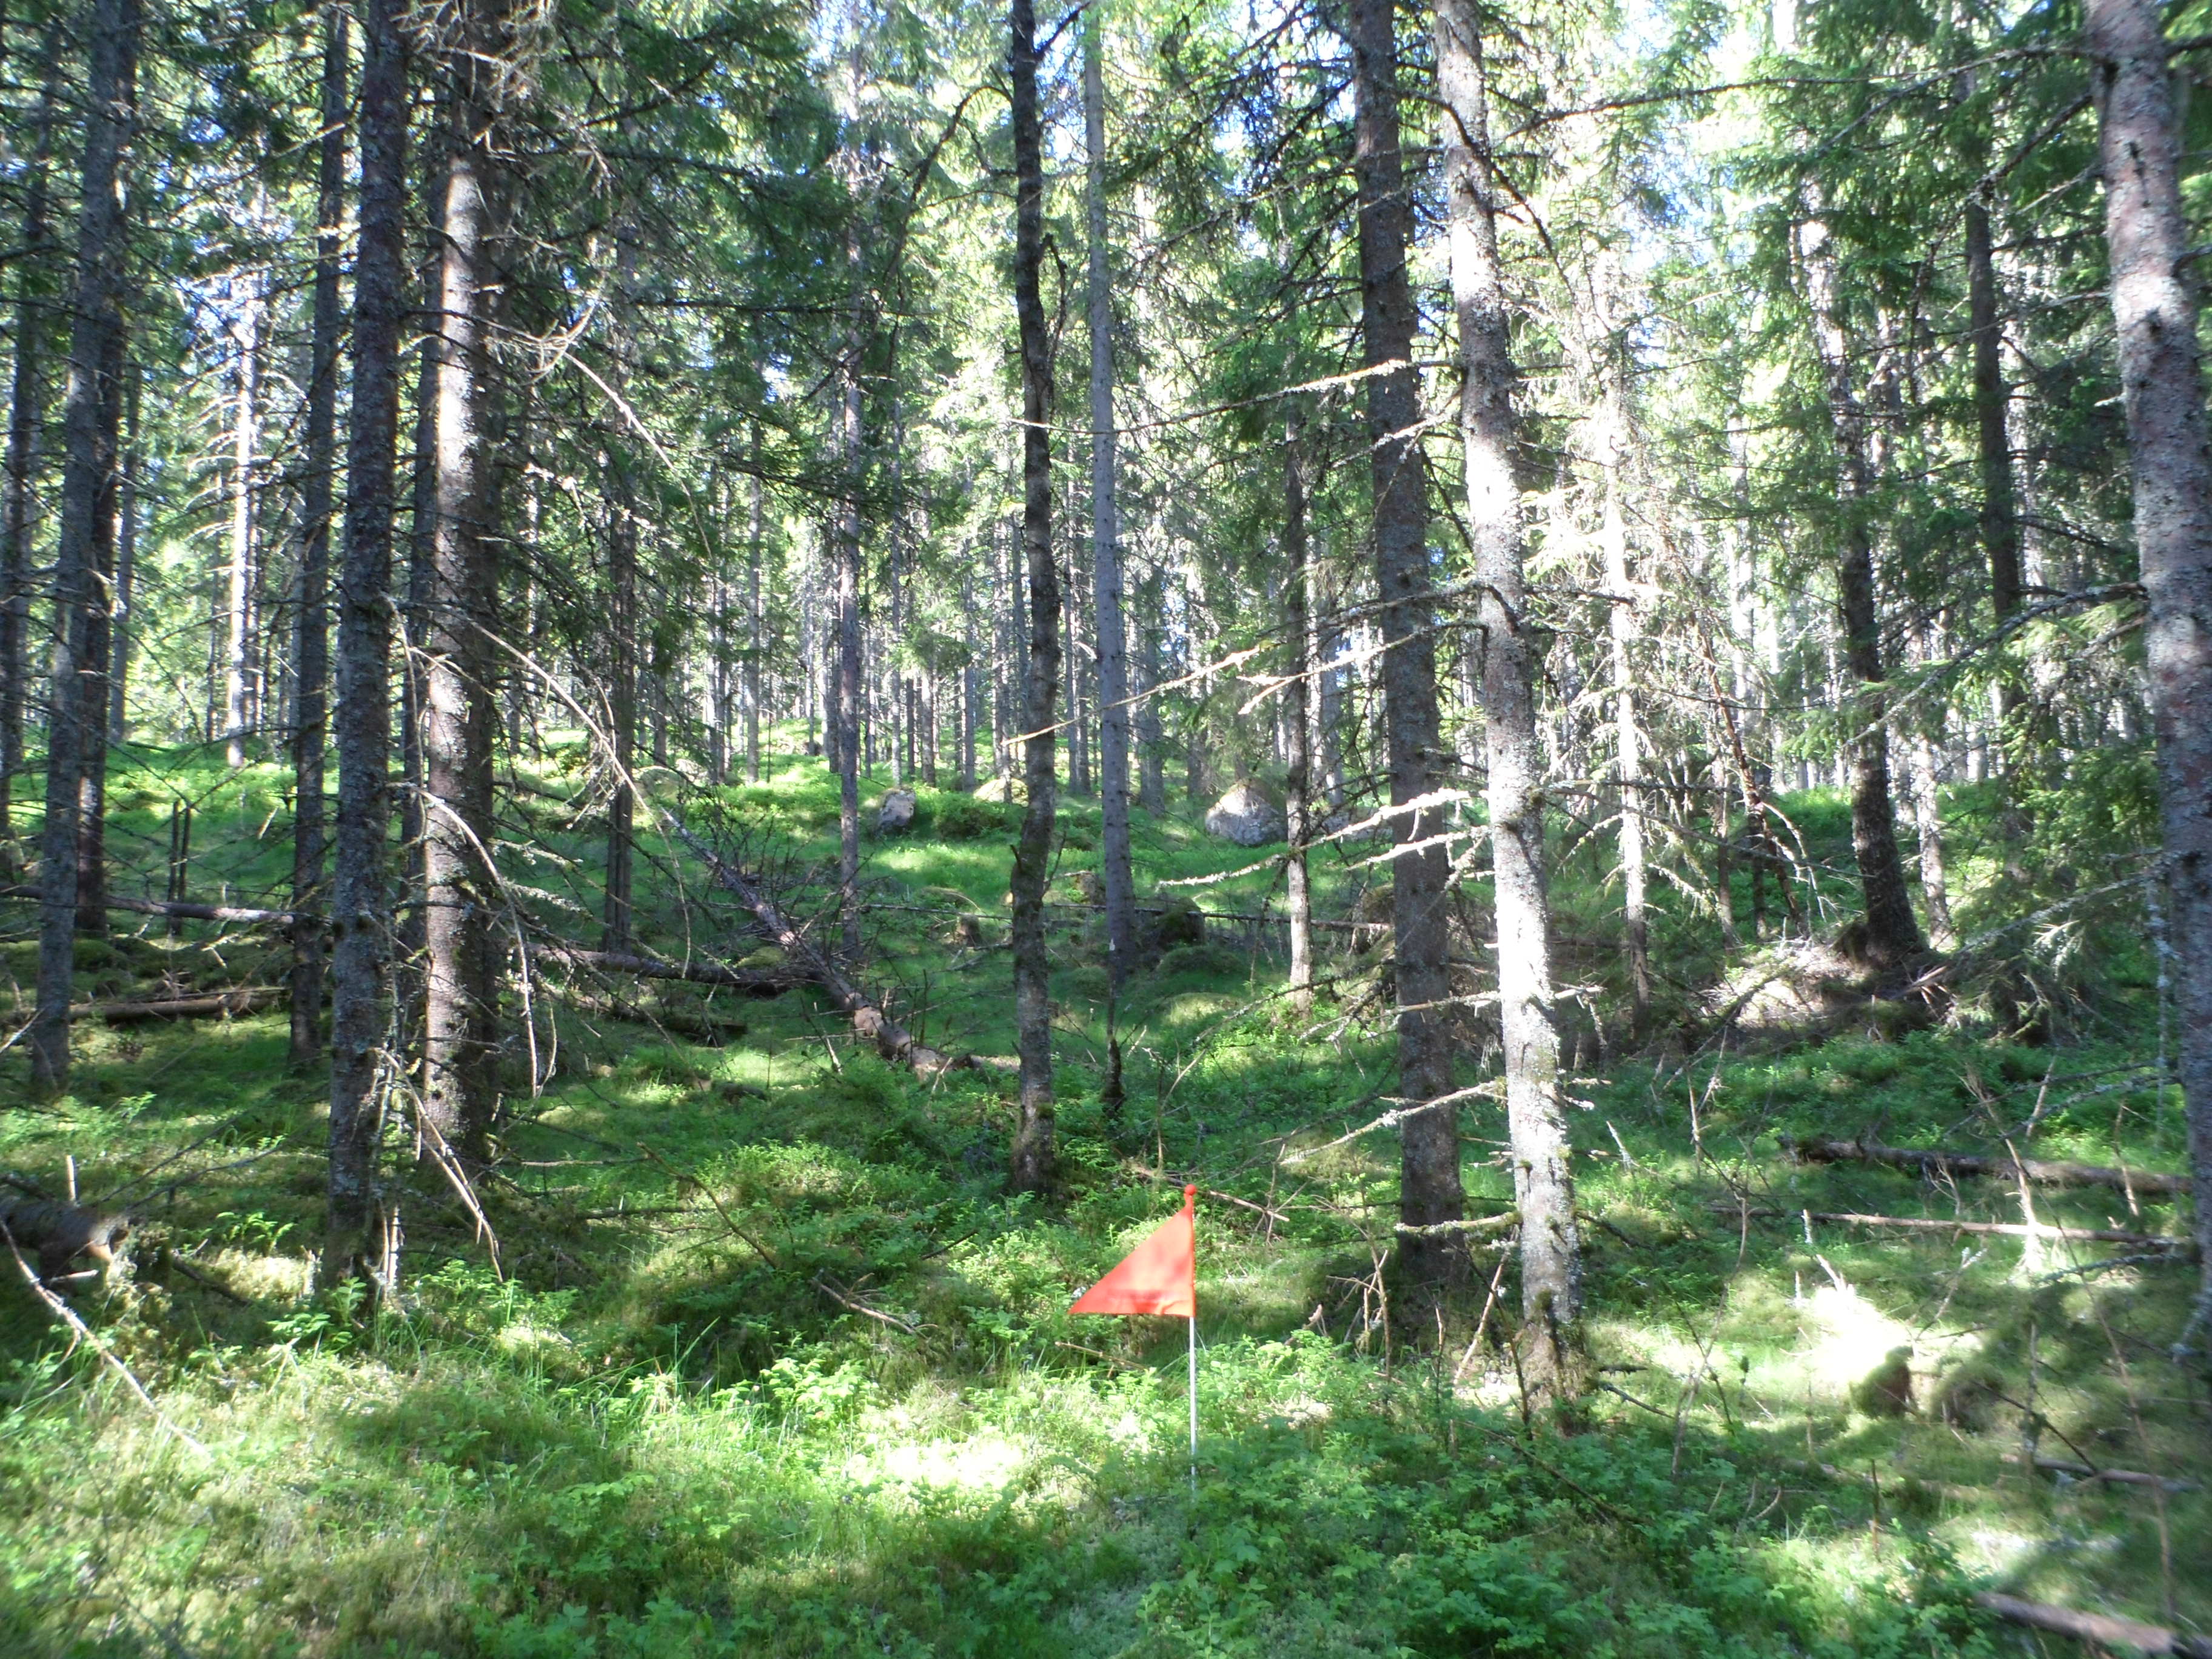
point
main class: Woodland
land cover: Spruce dominated coniferous woodland
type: boreal forest
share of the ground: 50 - 75 %
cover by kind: coniferous forest trees 70 %, lichens and mosses 15 %, shrubs 10 %, herbaceous plants 5 %
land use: Forestry
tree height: > 5 m
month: June
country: SE
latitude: 57.4603
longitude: 13.9128
